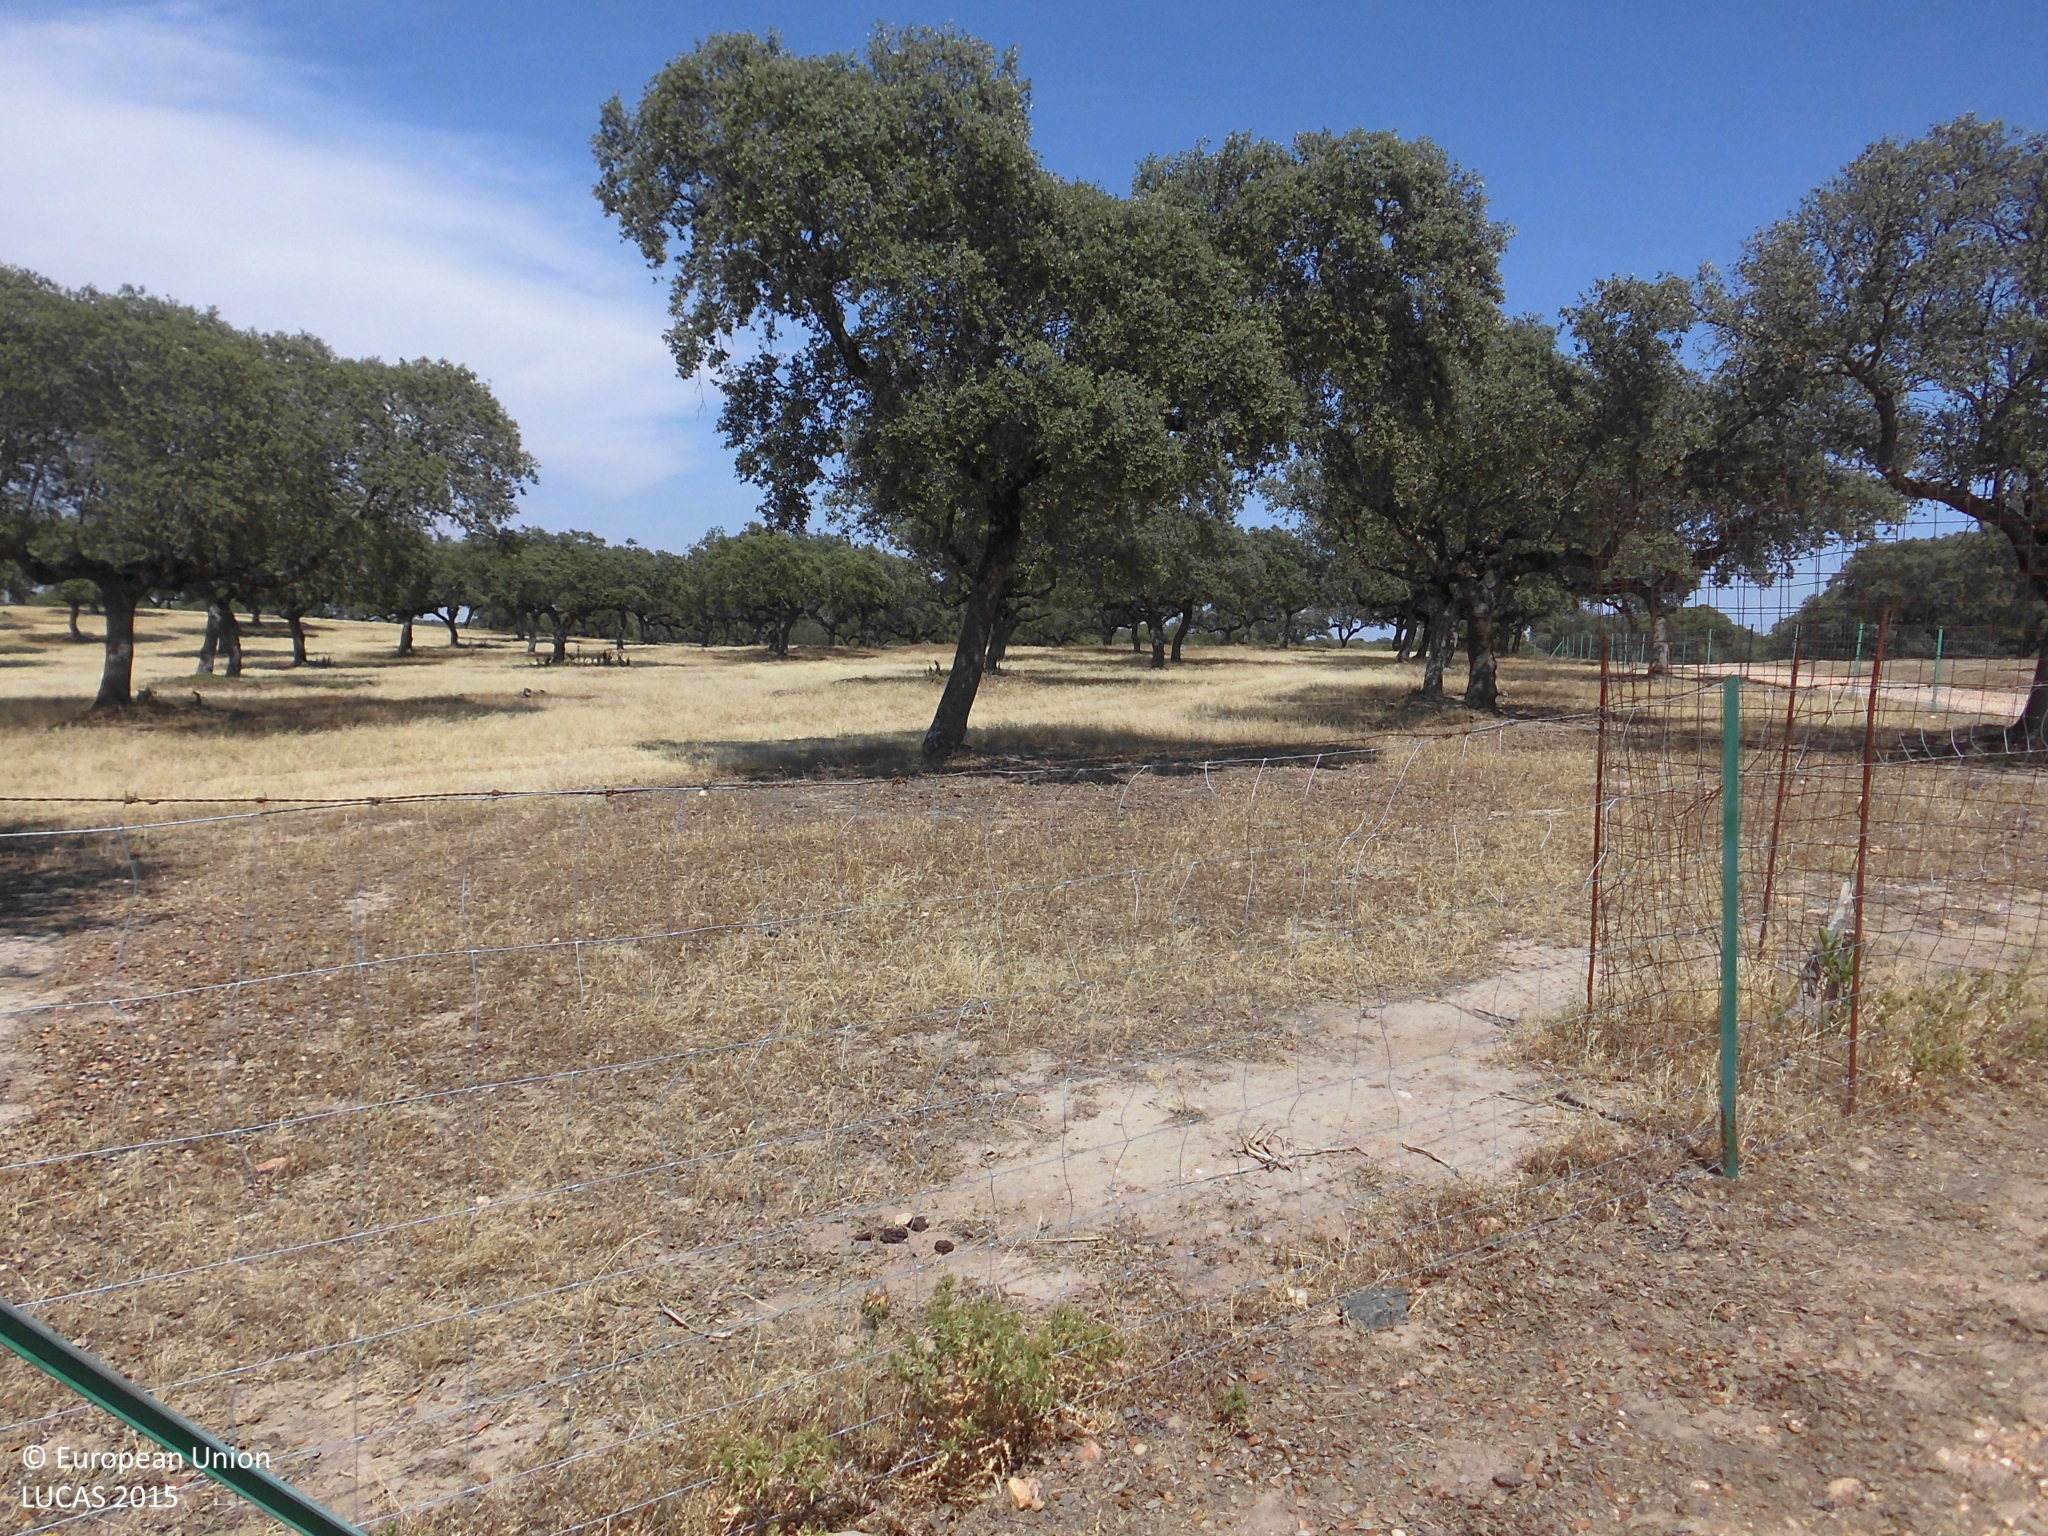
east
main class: Woodland
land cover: Broadleaved woodland
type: broadleaved evergreen forest
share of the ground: 25 - 50 %
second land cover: Grassland without tree/shrub cover
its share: > 75 %
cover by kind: herbaceous plants 65 %, broadleaved forest trees 35 %
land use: Forestry
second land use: Agriculture (excluding fallow land and kitchen gardens)
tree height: > 5 m
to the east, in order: Broadleaved woodland; Grassland without tree/shrub cover; Broadleaved woodland
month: June
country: ES
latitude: 39.7849
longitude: -6.1475
